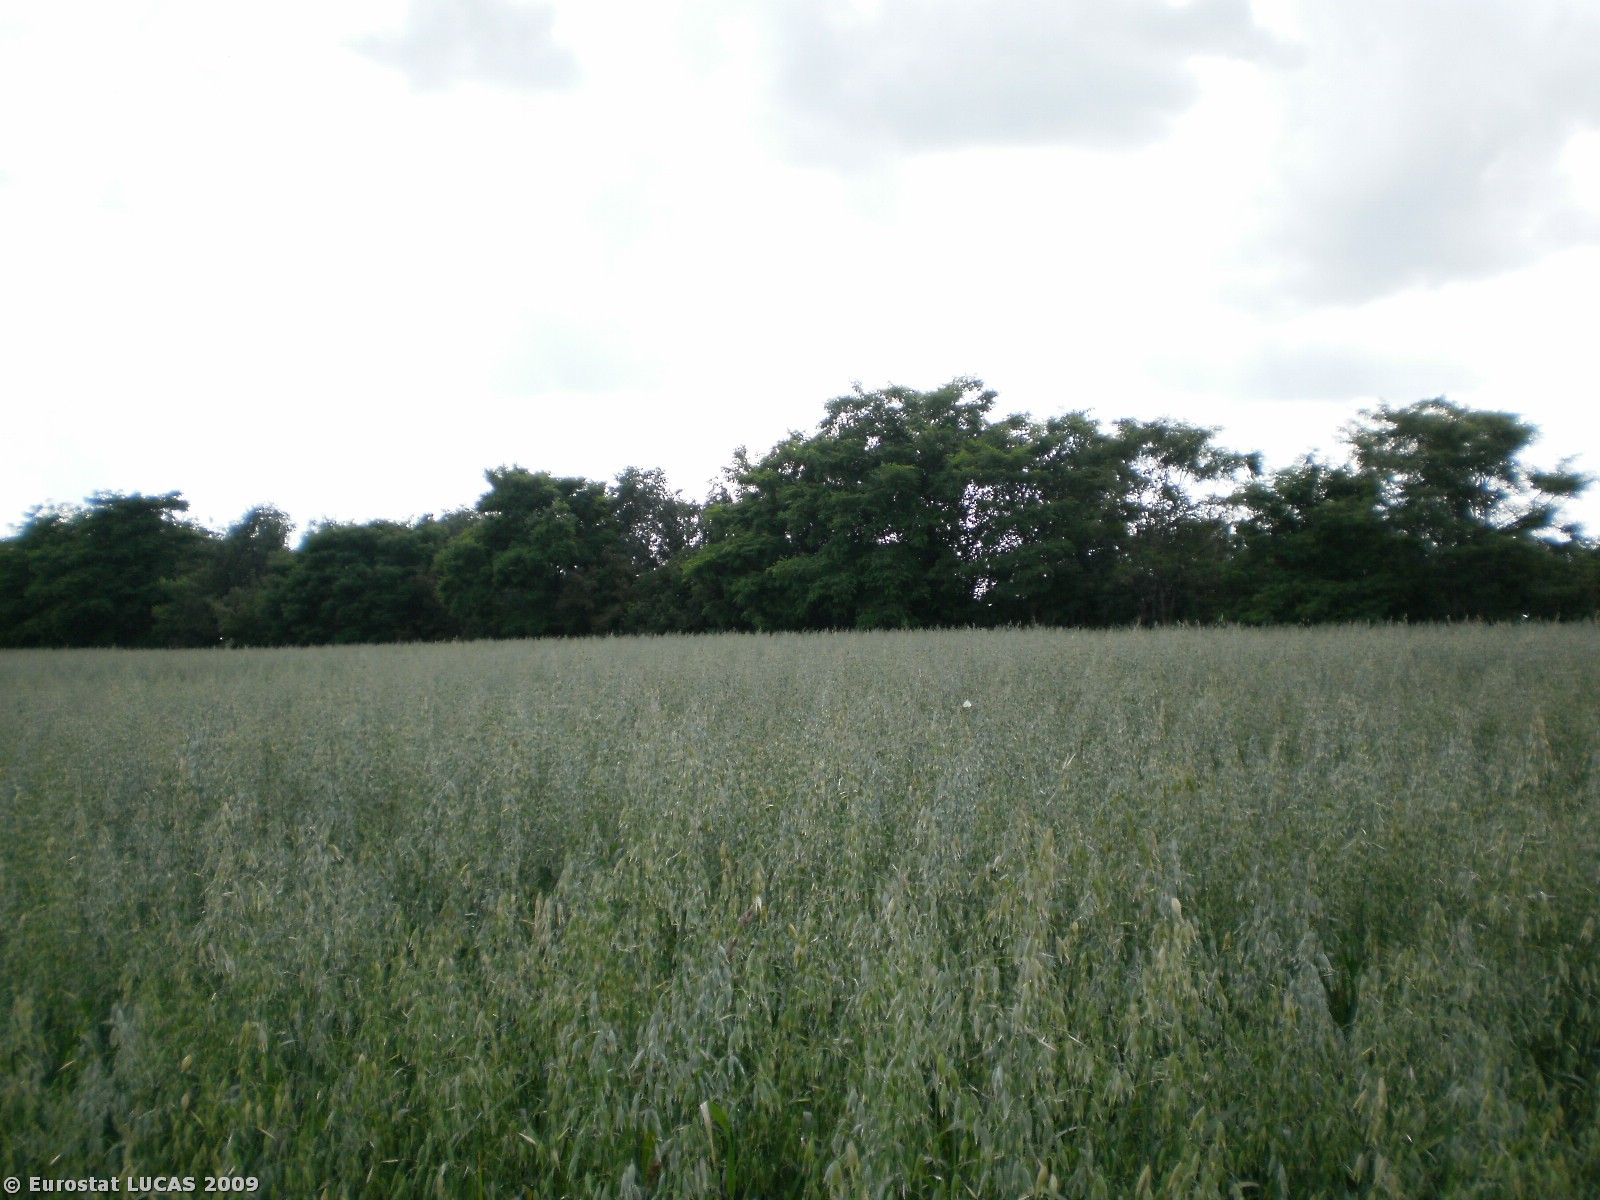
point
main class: Cropland
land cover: Oats
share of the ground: > 75 %
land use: Agriculture (excluding fallow land and kitchen gardens)
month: July
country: PL
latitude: 53.3300
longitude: 20.4424
